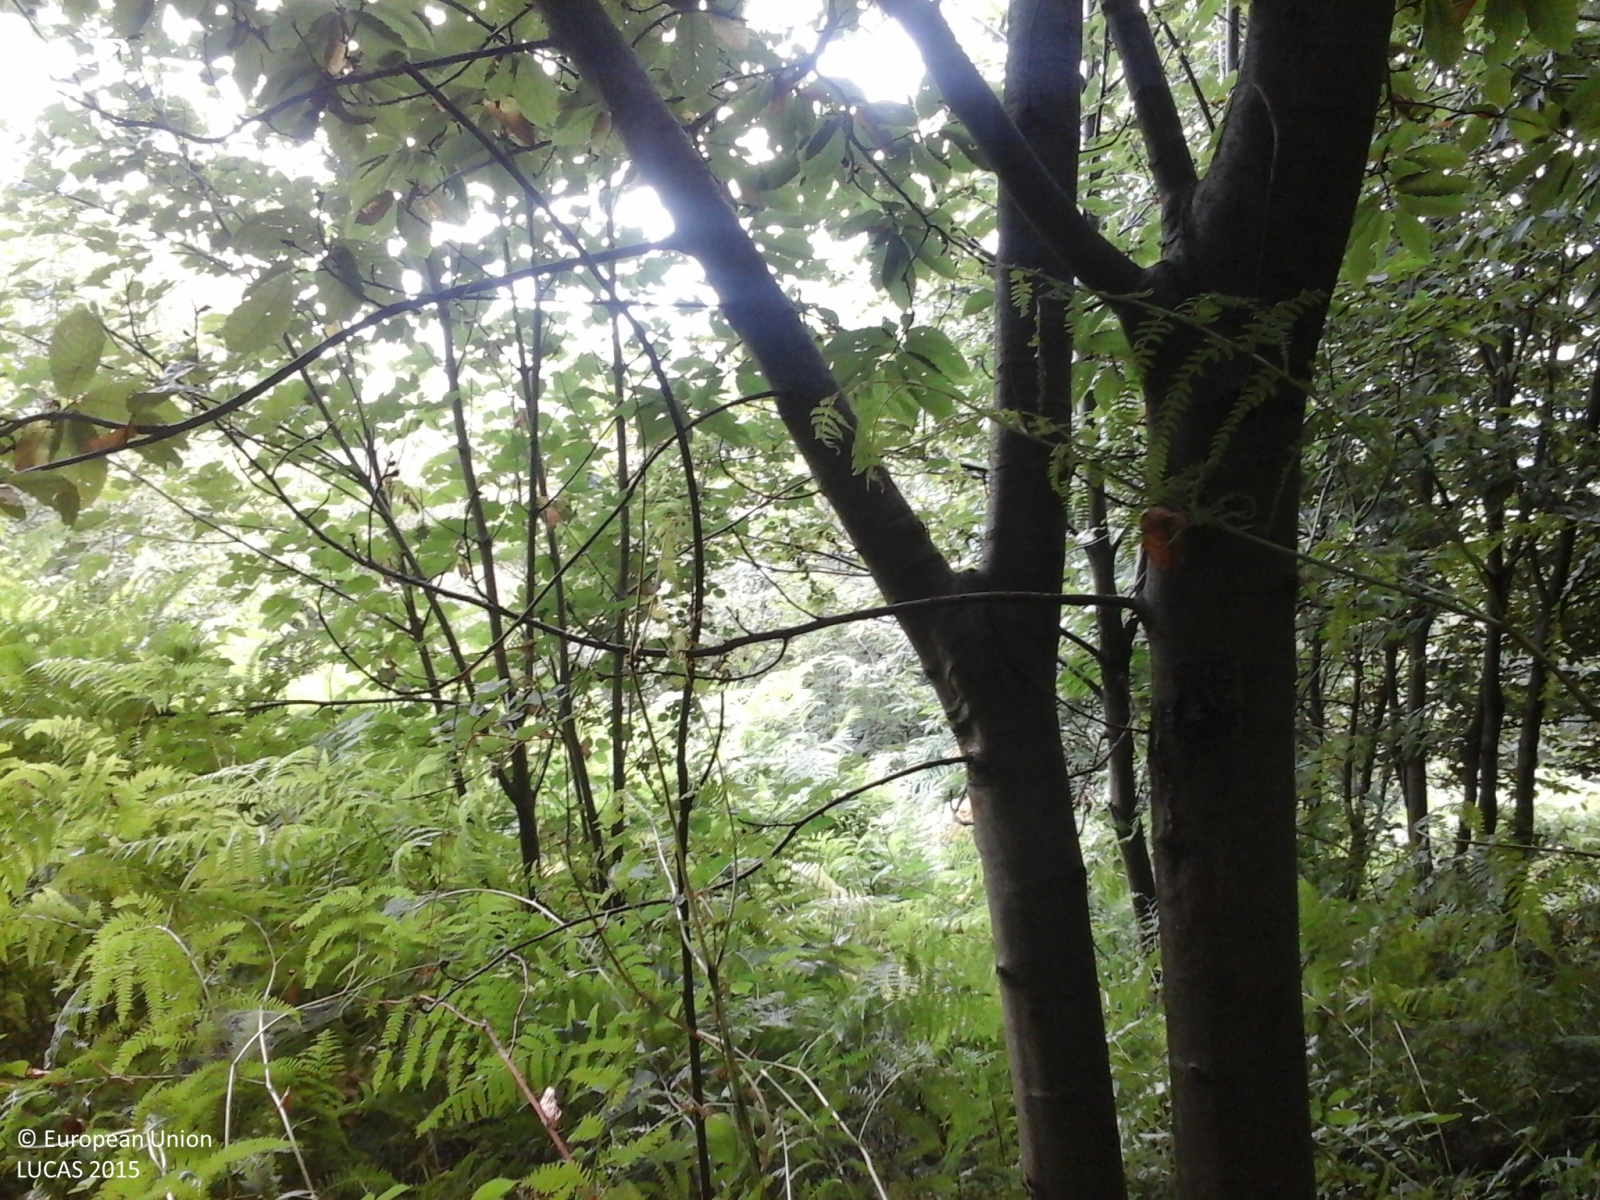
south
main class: Woodland
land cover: Broadleaved woodland
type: thermophilous deciduous forest
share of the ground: > 75 %
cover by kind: broadleaved forest trees 100 %
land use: Semi-natural and natural areas not in use
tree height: > 5 m
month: July
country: IT
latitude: 45.4436
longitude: 7.7151
